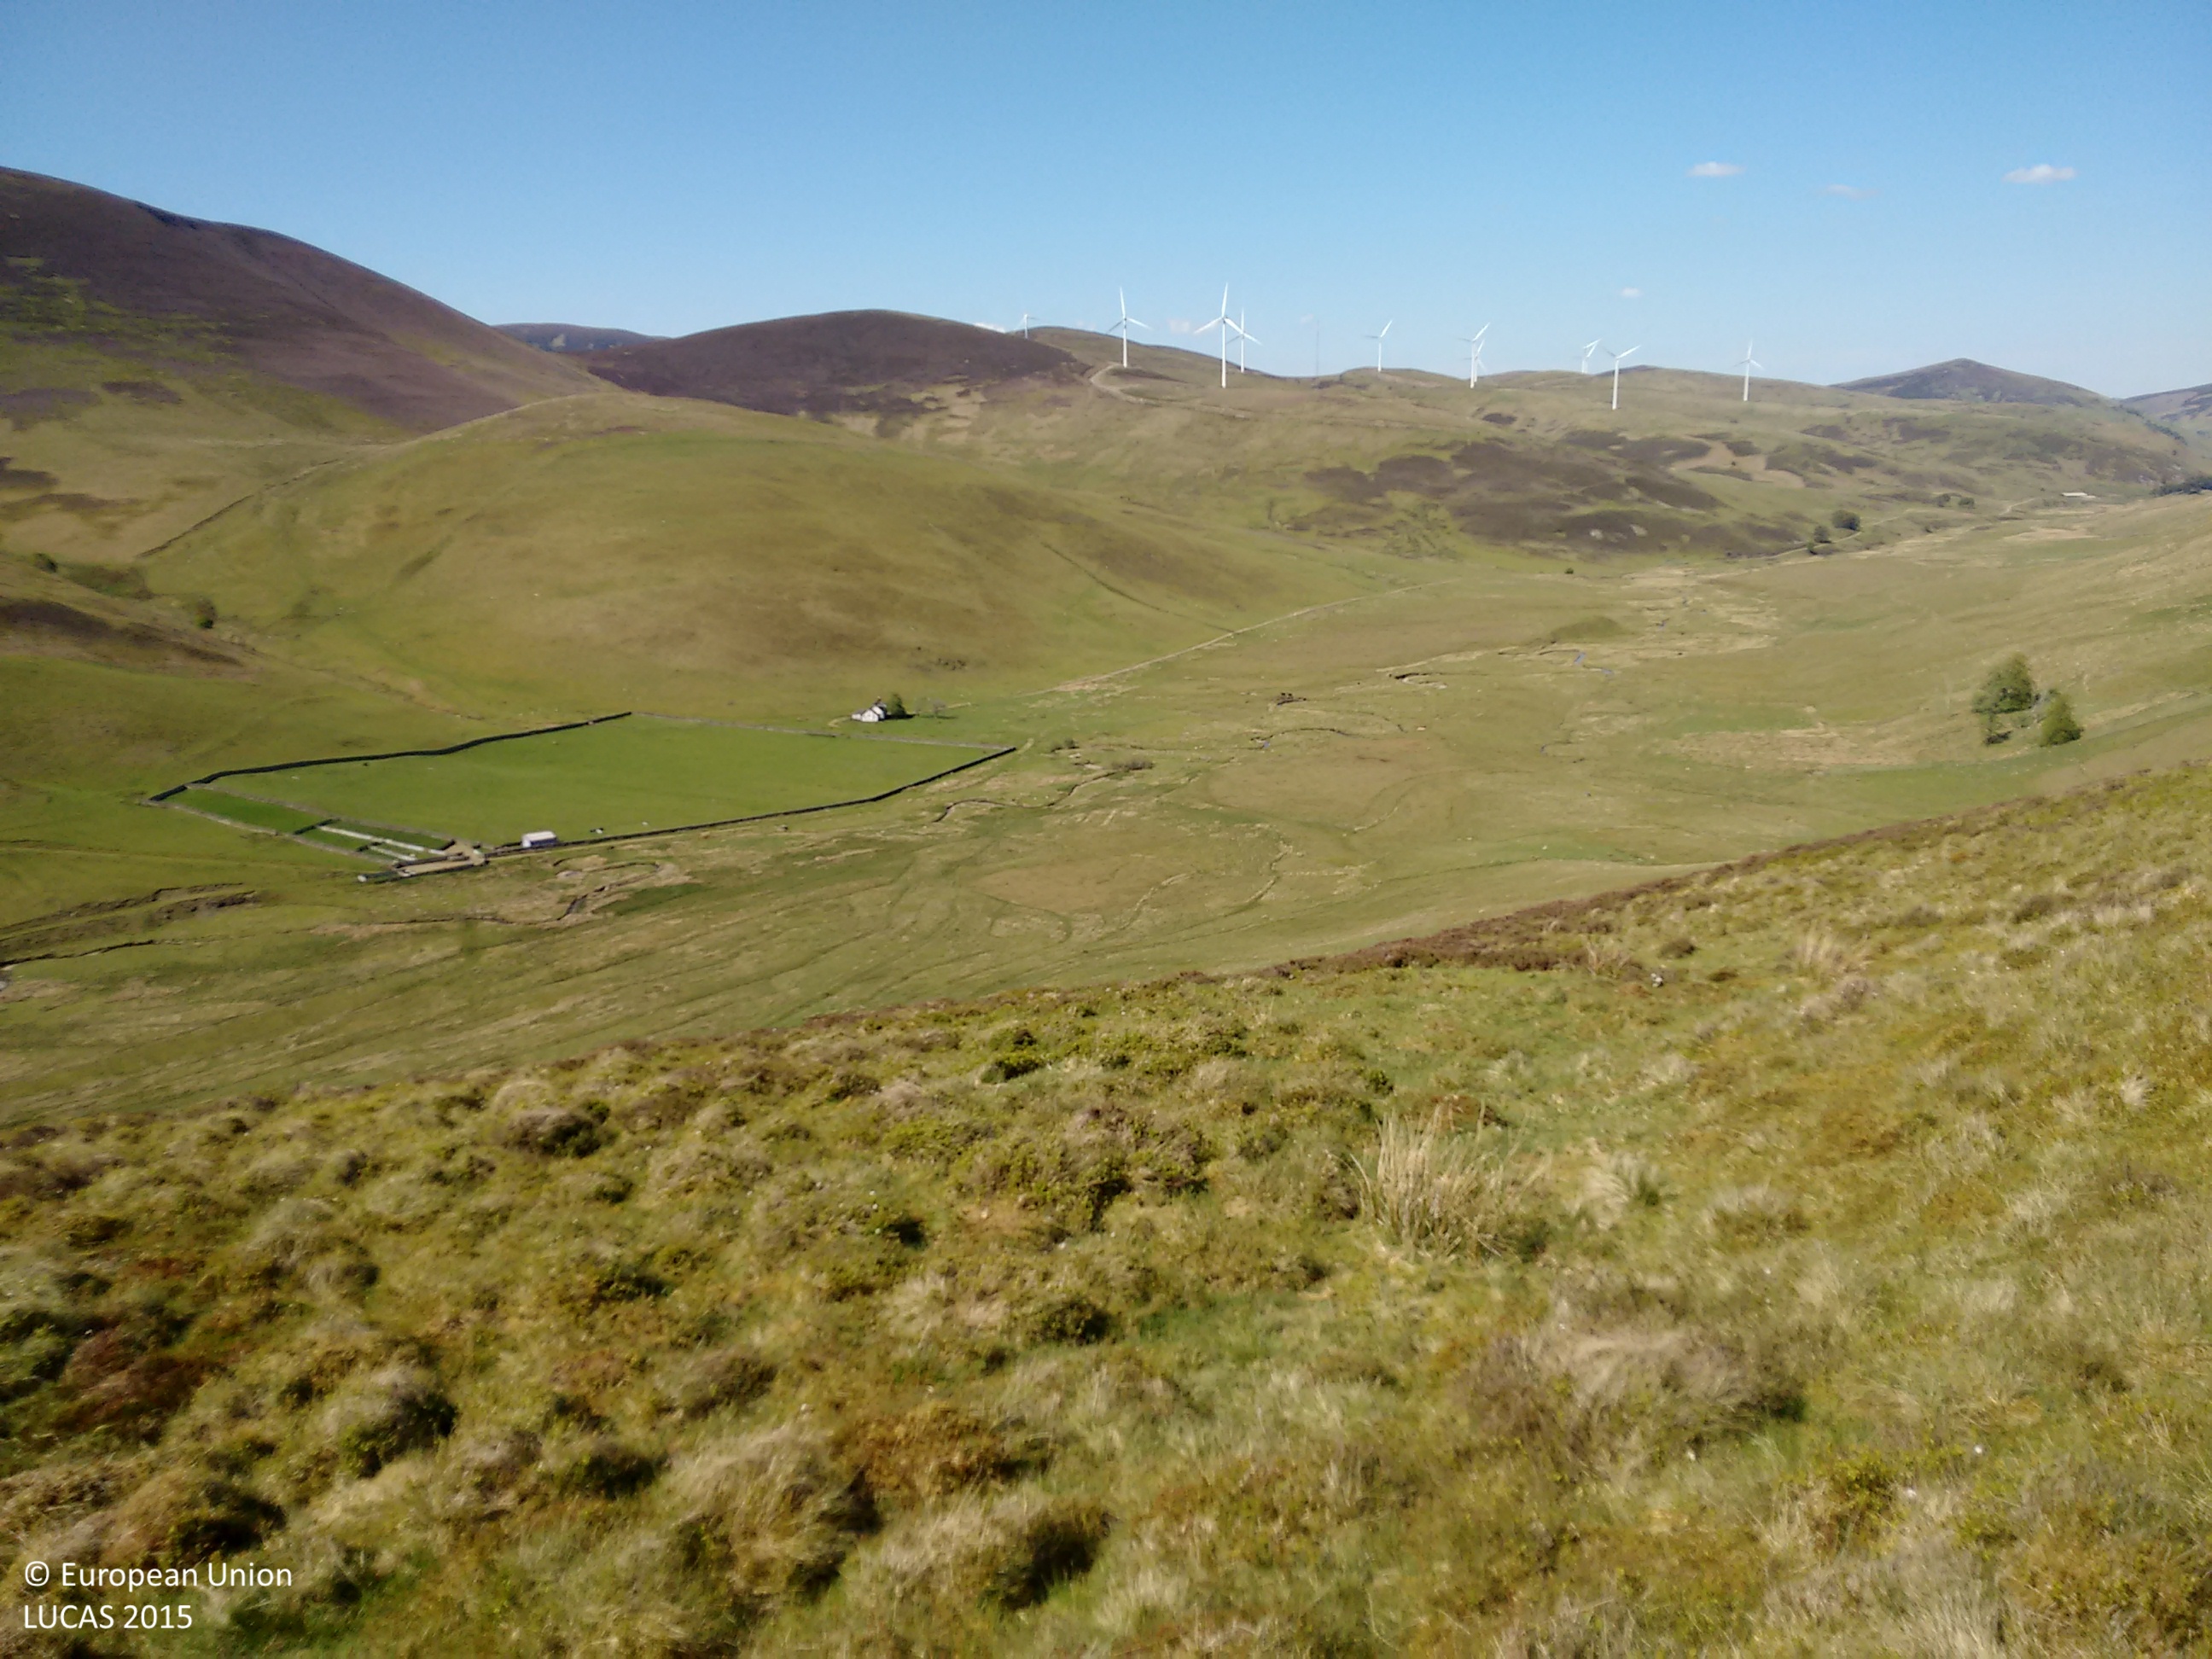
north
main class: Shrubland
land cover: Shrubland without tree cover
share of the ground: 25 - 50 %
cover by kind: shrubs 45 %, herbaceous plants 45 %, lichens and mosses 10 %
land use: Semi-natural and natural areas not in use
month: June
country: GB
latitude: 55.5109
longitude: -3.4588
